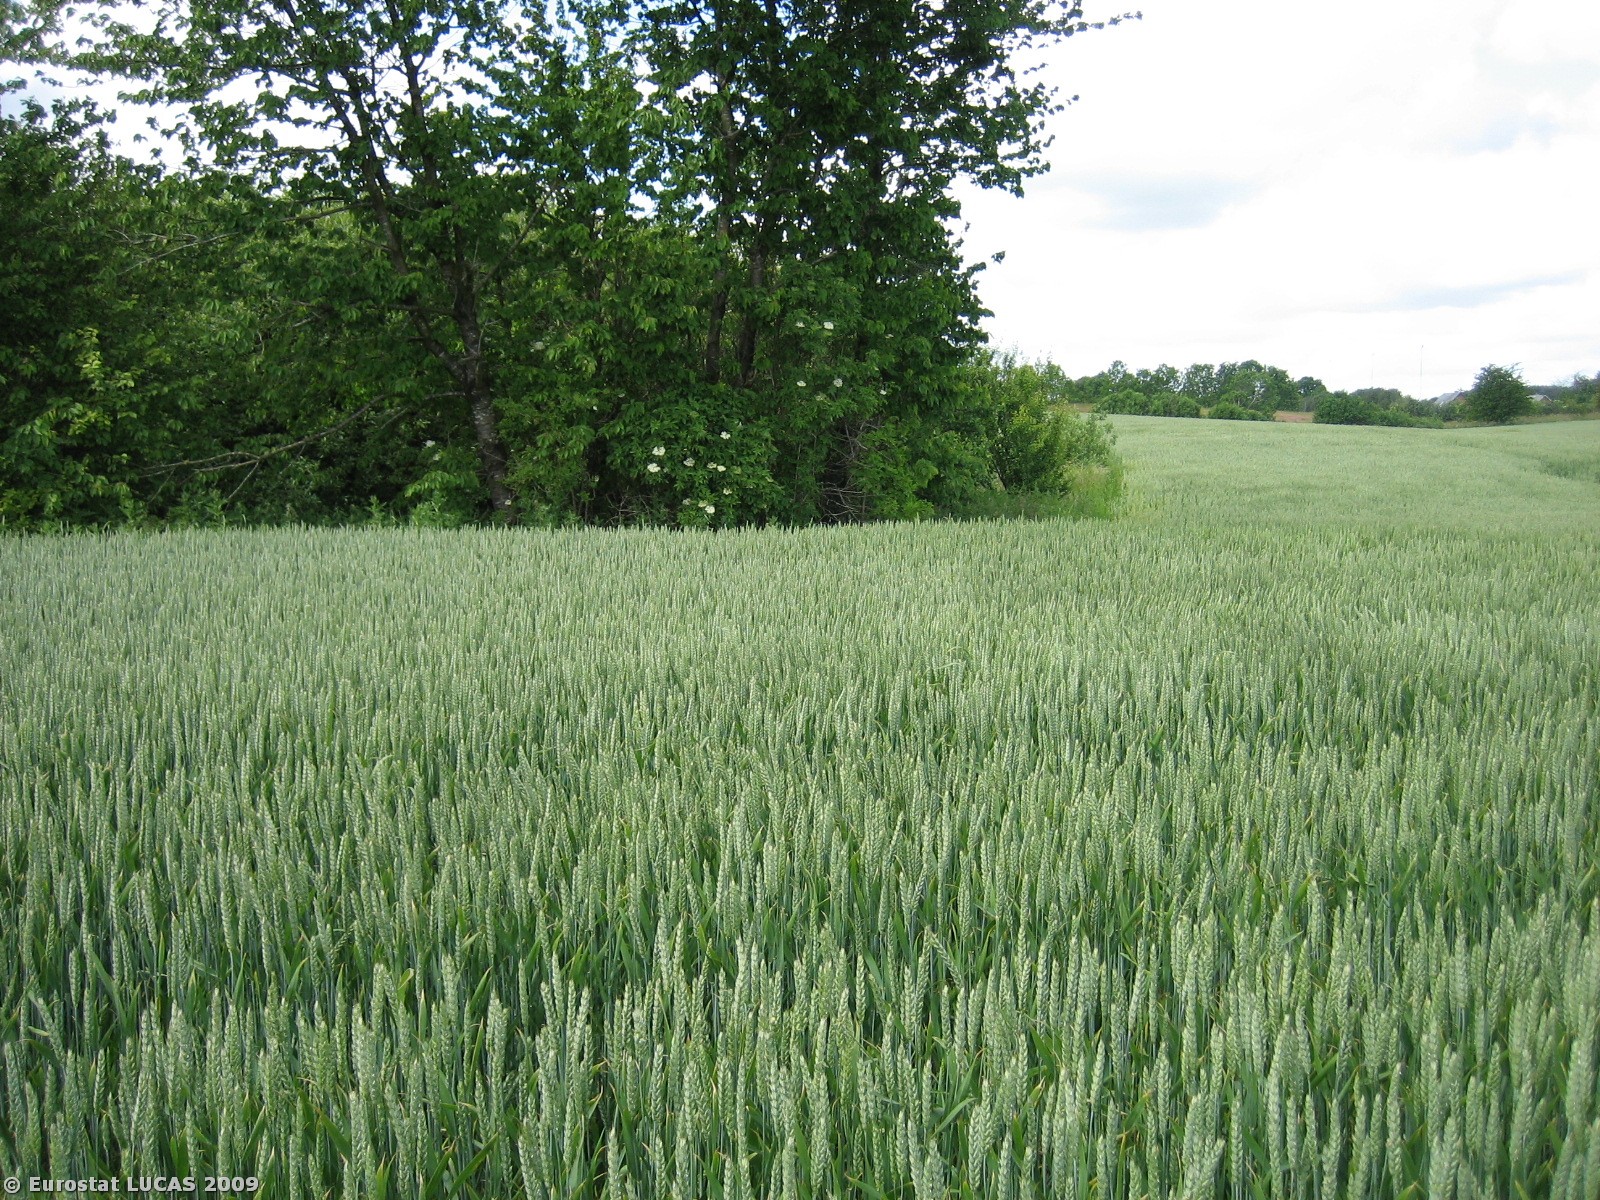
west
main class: Cropland
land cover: Common wheat
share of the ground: > 75 %
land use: Agriculture (excluding fallow land and kitchen gardens)
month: June
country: DK
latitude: 55.7006
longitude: 9.3165
